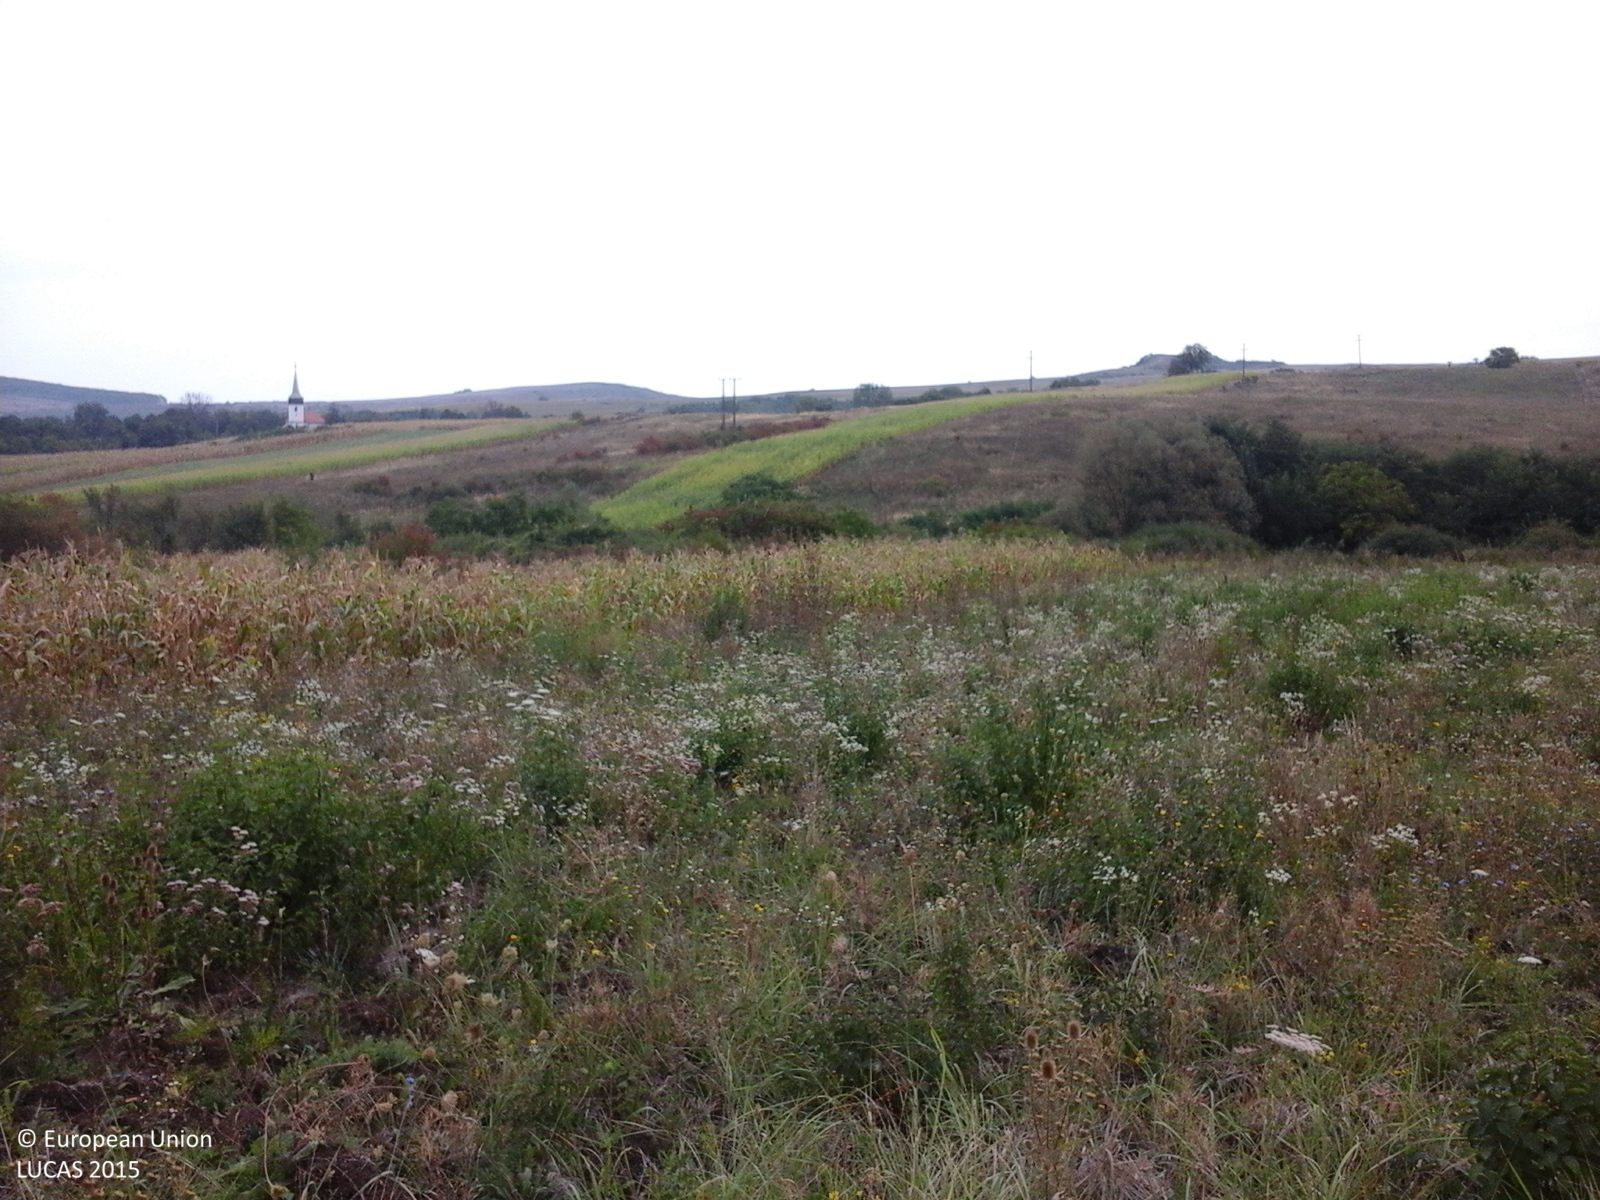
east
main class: Grassland
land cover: Spontaneously vegetated surfaces
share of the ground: > 75 %
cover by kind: herbaceous plants 100 %
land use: Fallow land
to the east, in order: Spontaneously vegetated surfaces; Maize; Shruby margins; Tracks; Shruby margins; Shrubland with sparse tree cover; Rivers and streams; Shrubland without tree cover; Spontaneously vegetated surfaces; Maize; Spontaneously vegetated surfaces; Electric lines; Spontaneously vegetated surfaces
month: September
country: RO
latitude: 47.2577
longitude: 23.0815
